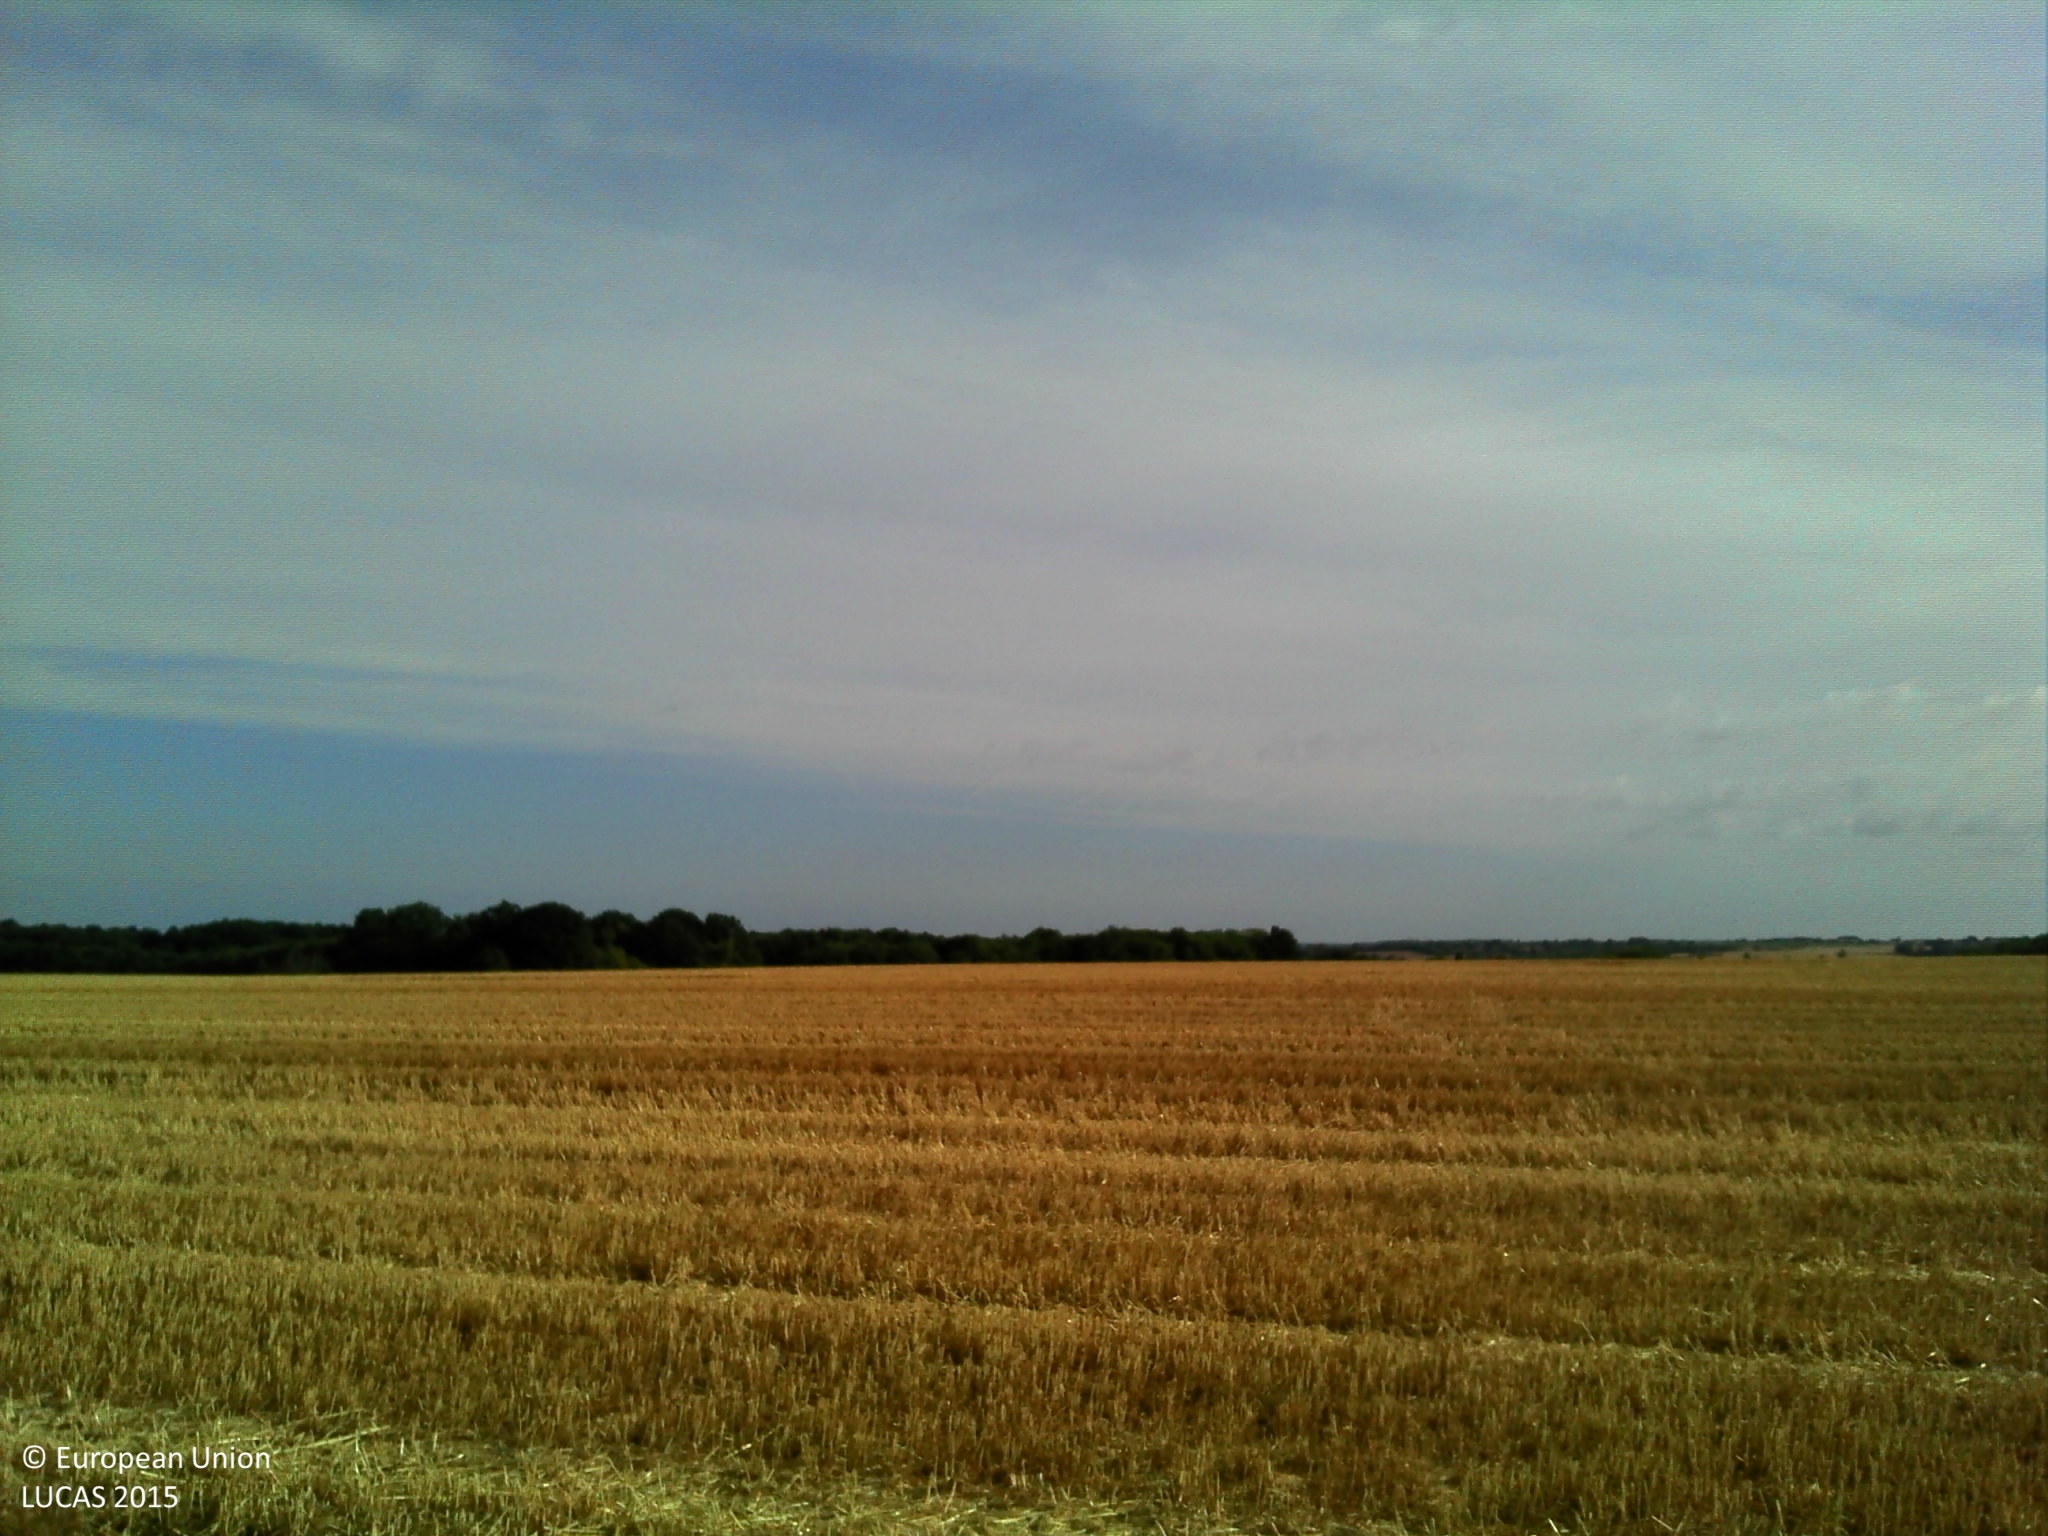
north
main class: Cropland
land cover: Common wheat
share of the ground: > 75 %
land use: Agriculture (excluding fallow land and kitchen gardens)
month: July
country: FR
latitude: 47.7890
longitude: 0.6482
